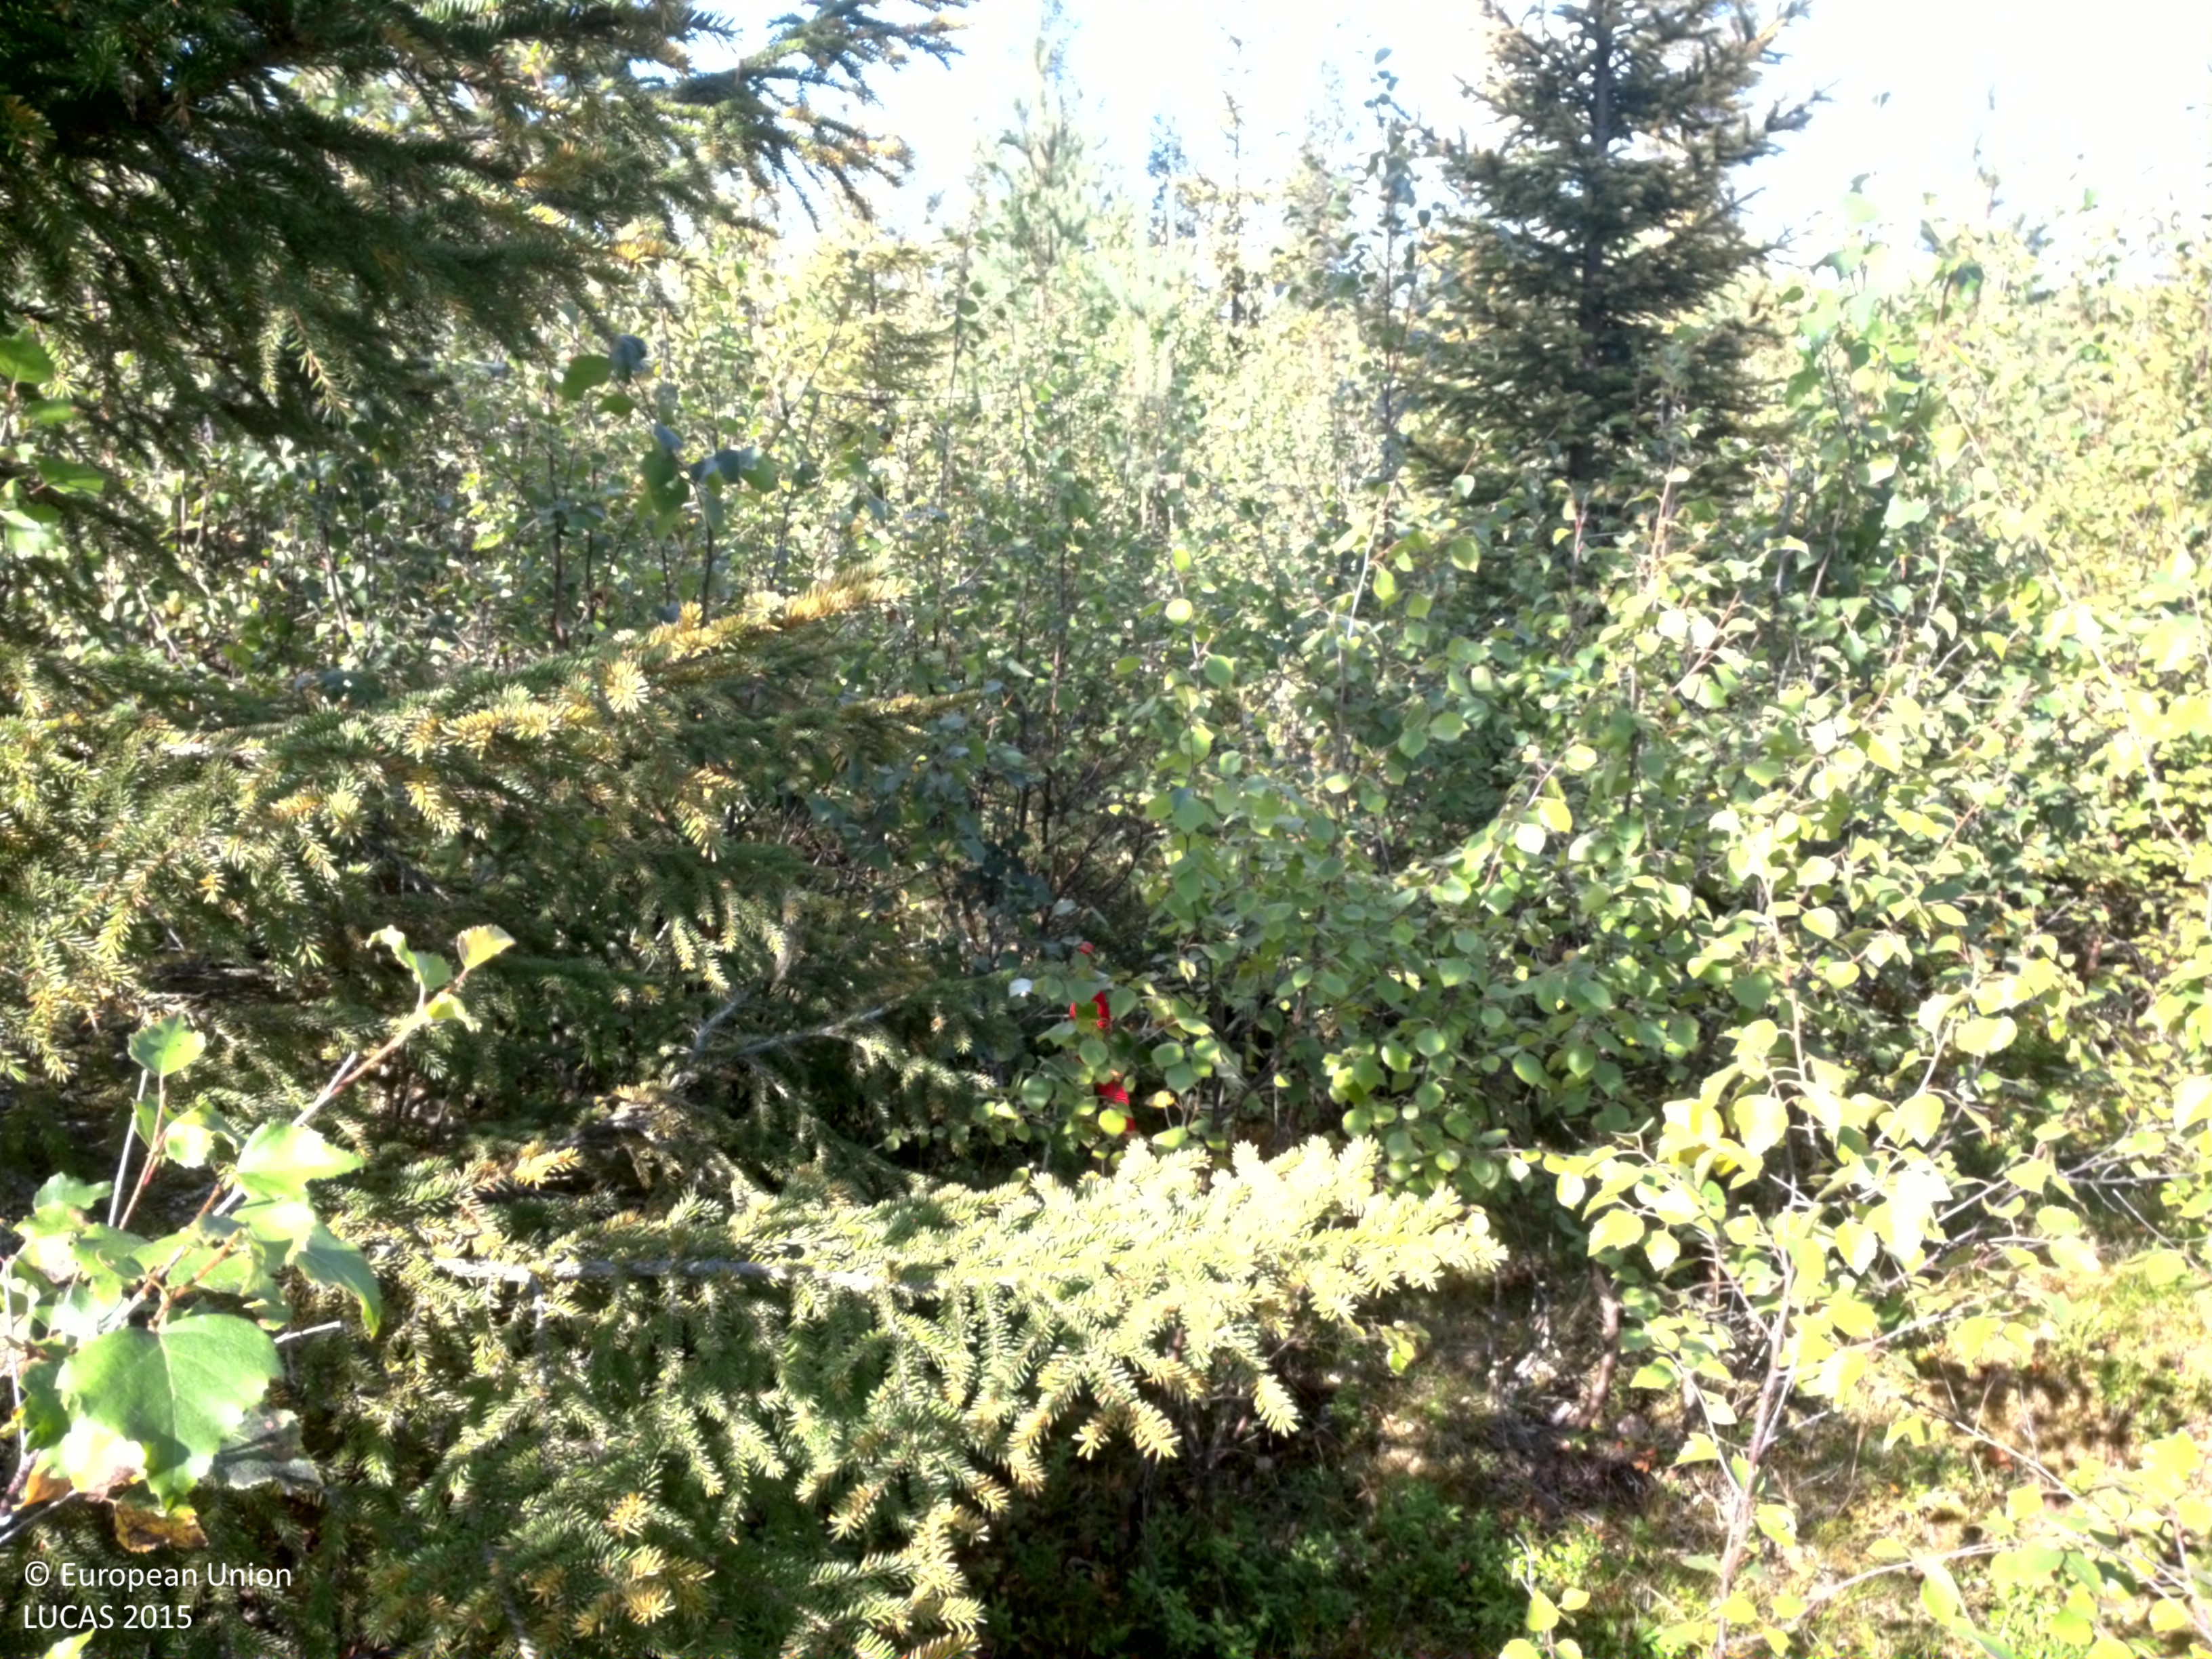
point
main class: Woodland
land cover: Broadleaved woodland
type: boreal forest
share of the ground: > 75 %
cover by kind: broadleaved forest trees 65 %, coniferous forest trees 15 %, herbaceous plants 10 %, shrubs 5 %, lichens and mosses 5 %
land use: Forestry
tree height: > 5 m
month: August
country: SE
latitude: 64.5226
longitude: 19.0331
